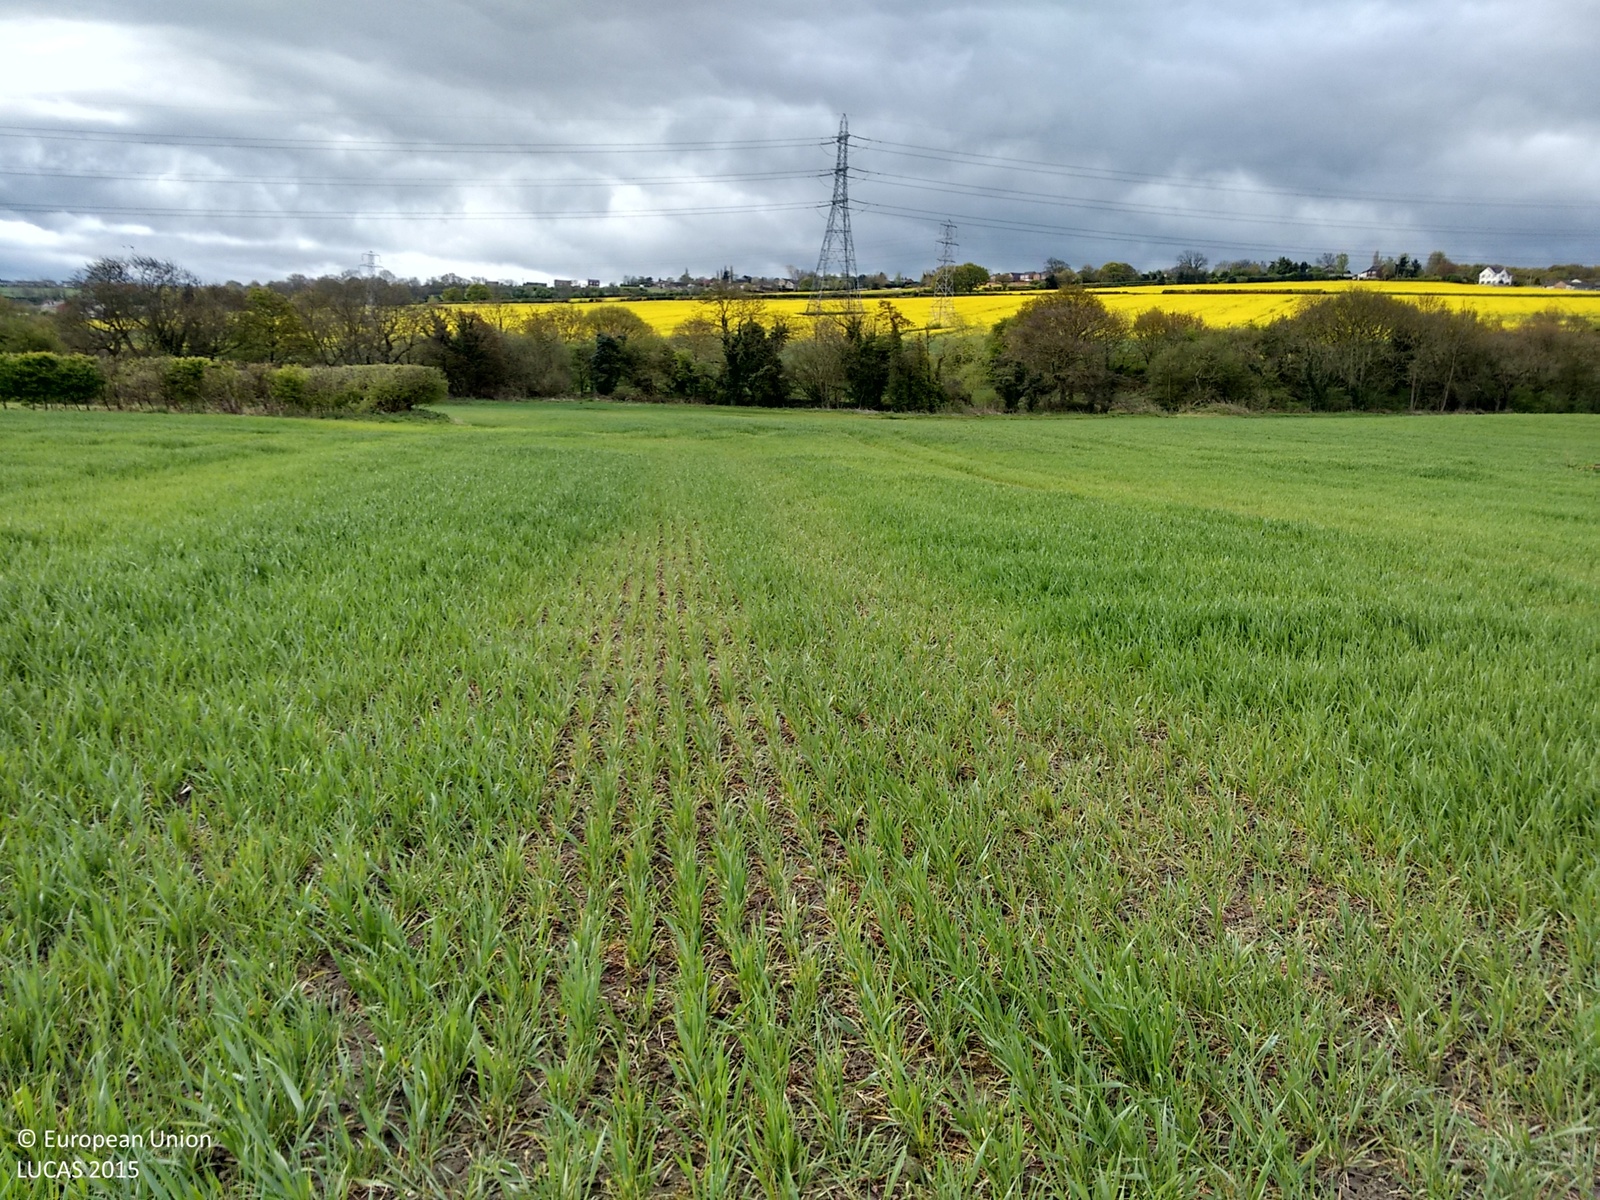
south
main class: Cropland
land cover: Common wheat
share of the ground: > 75 %
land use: Agriculture (excluding fallow land and kitchen gardens)
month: April
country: GB
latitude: 53.6603
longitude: -1.5974
